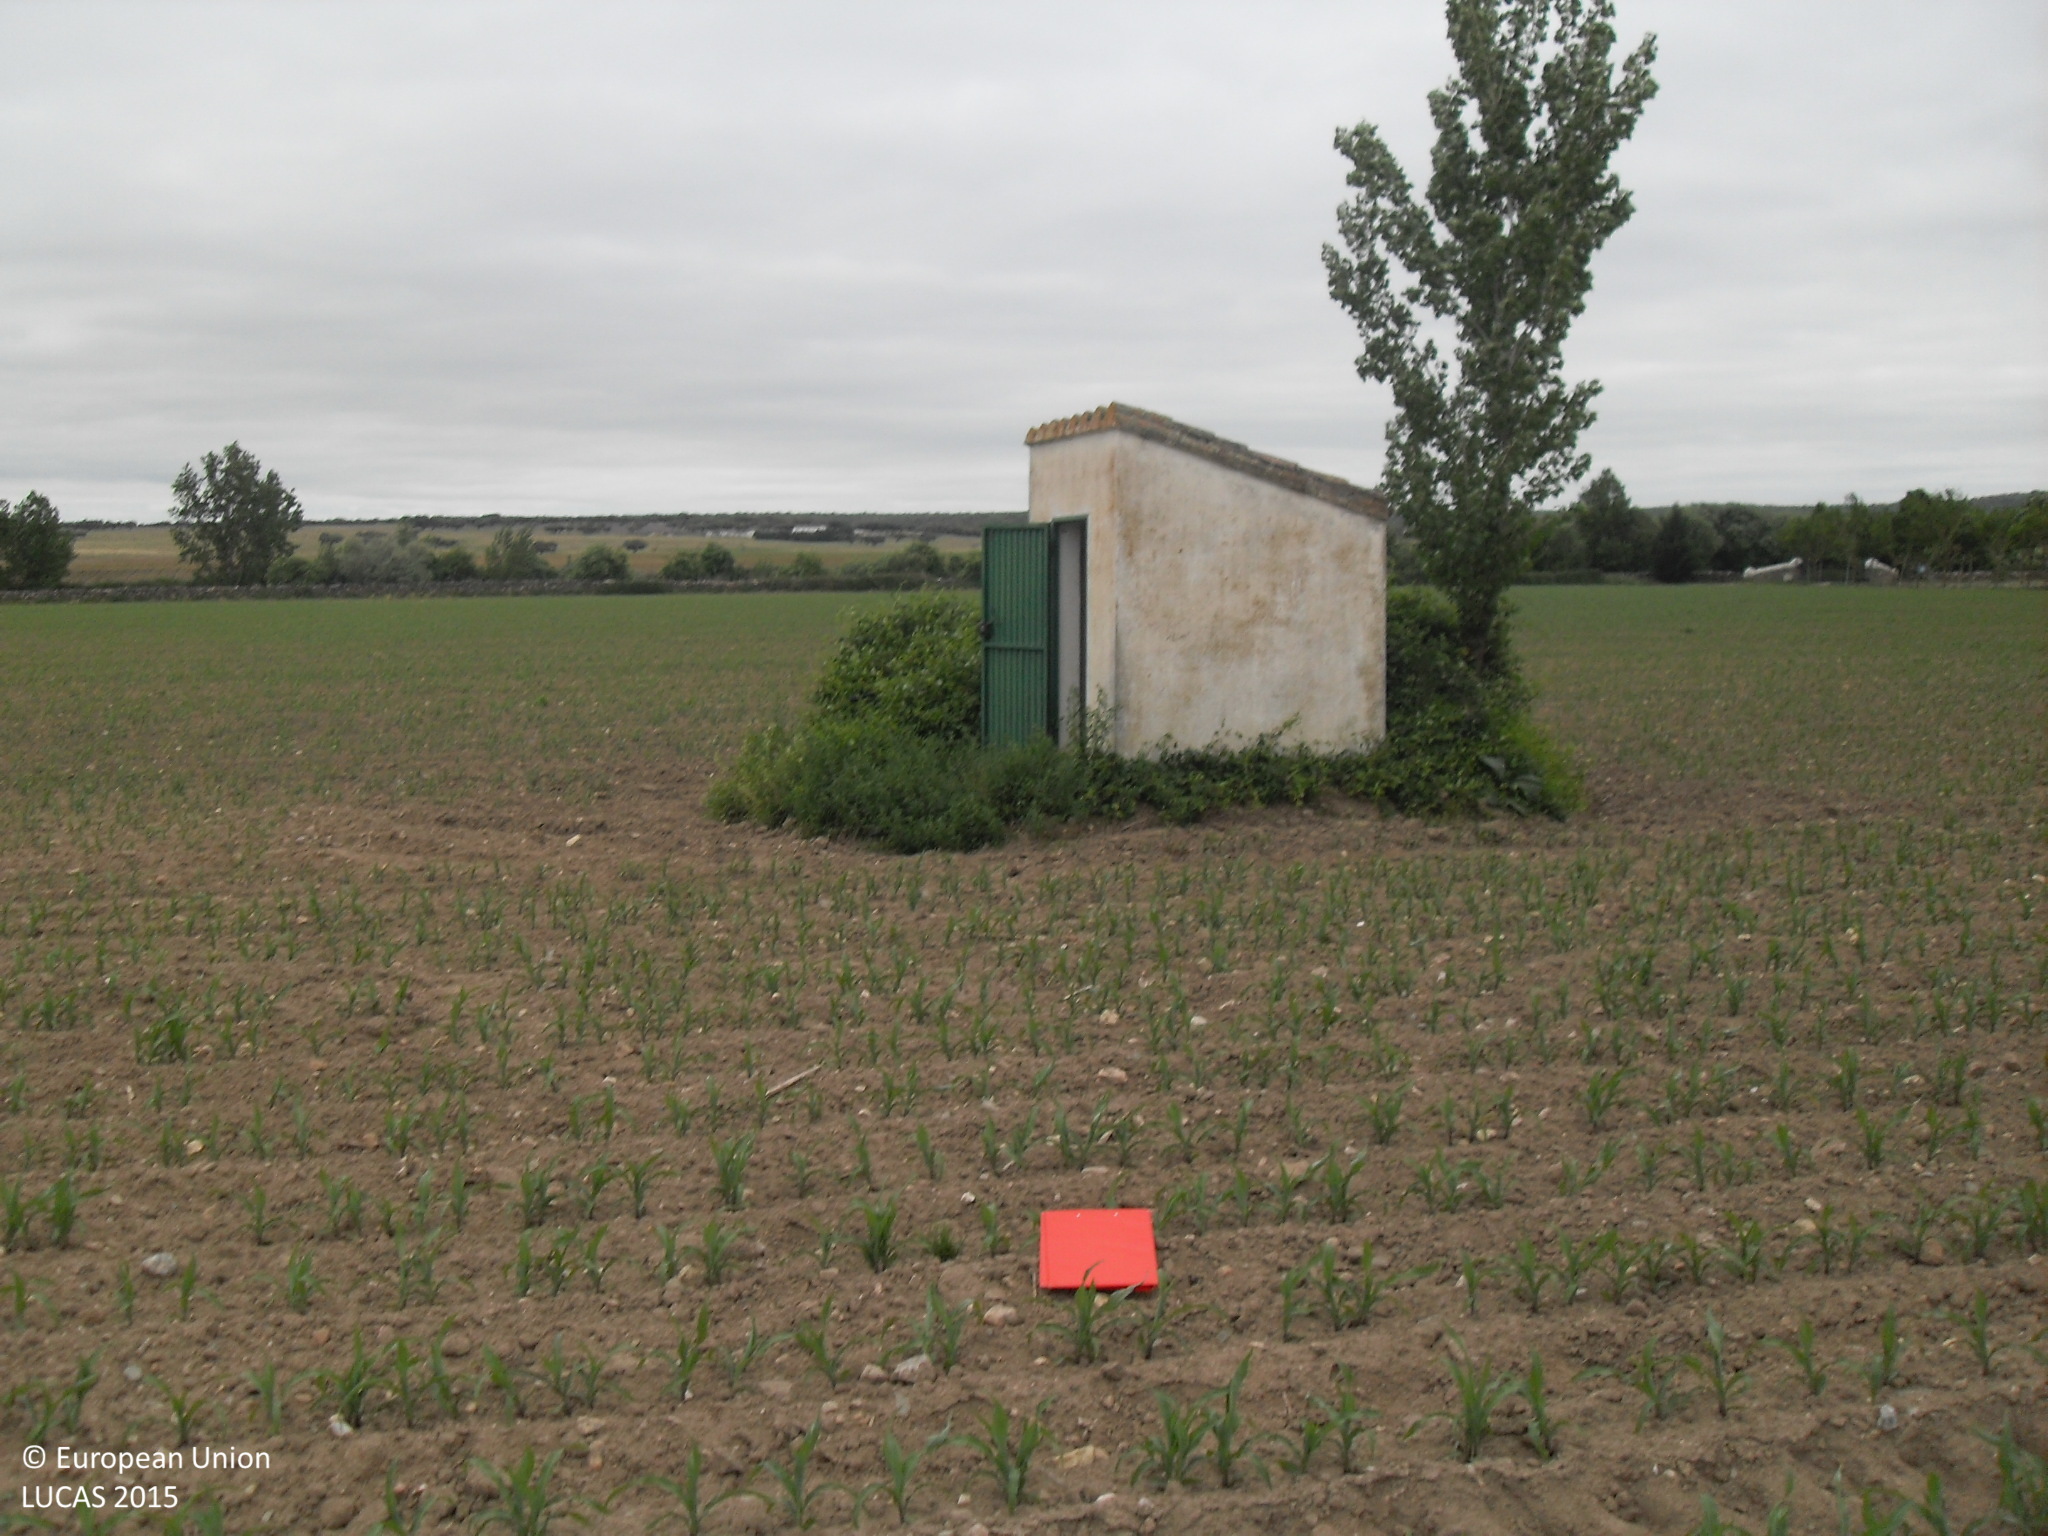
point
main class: Cropland
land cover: Maize
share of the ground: > 75 %
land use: Agriculture (excluding fallow land and kitchen gardens)
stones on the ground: < 10 %
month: May
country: ES
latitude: 40.6889
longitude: -5.6813
